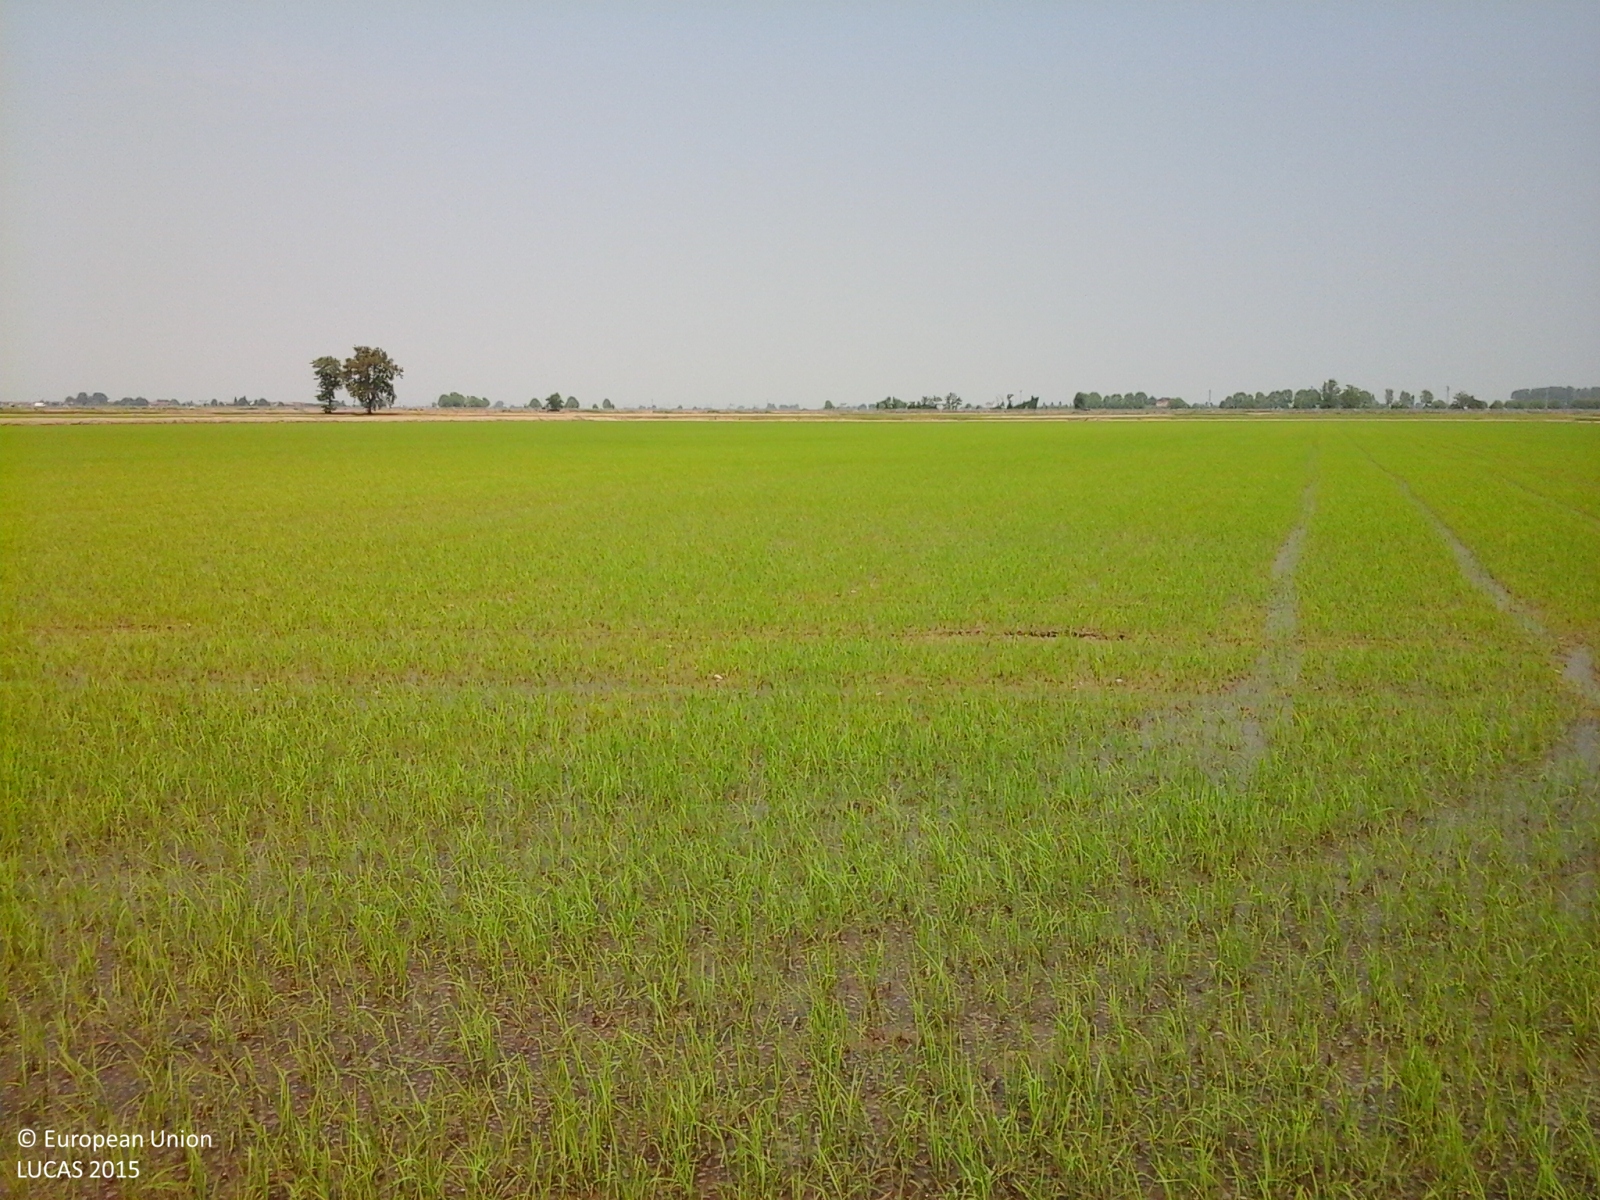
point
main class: Cropland
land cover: Rice
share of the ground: 25 - 50 %
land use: Agriculture (excluding fallow land and kitchen gardens)
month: May
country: IT
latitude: 45.3286
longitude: 8.3060
